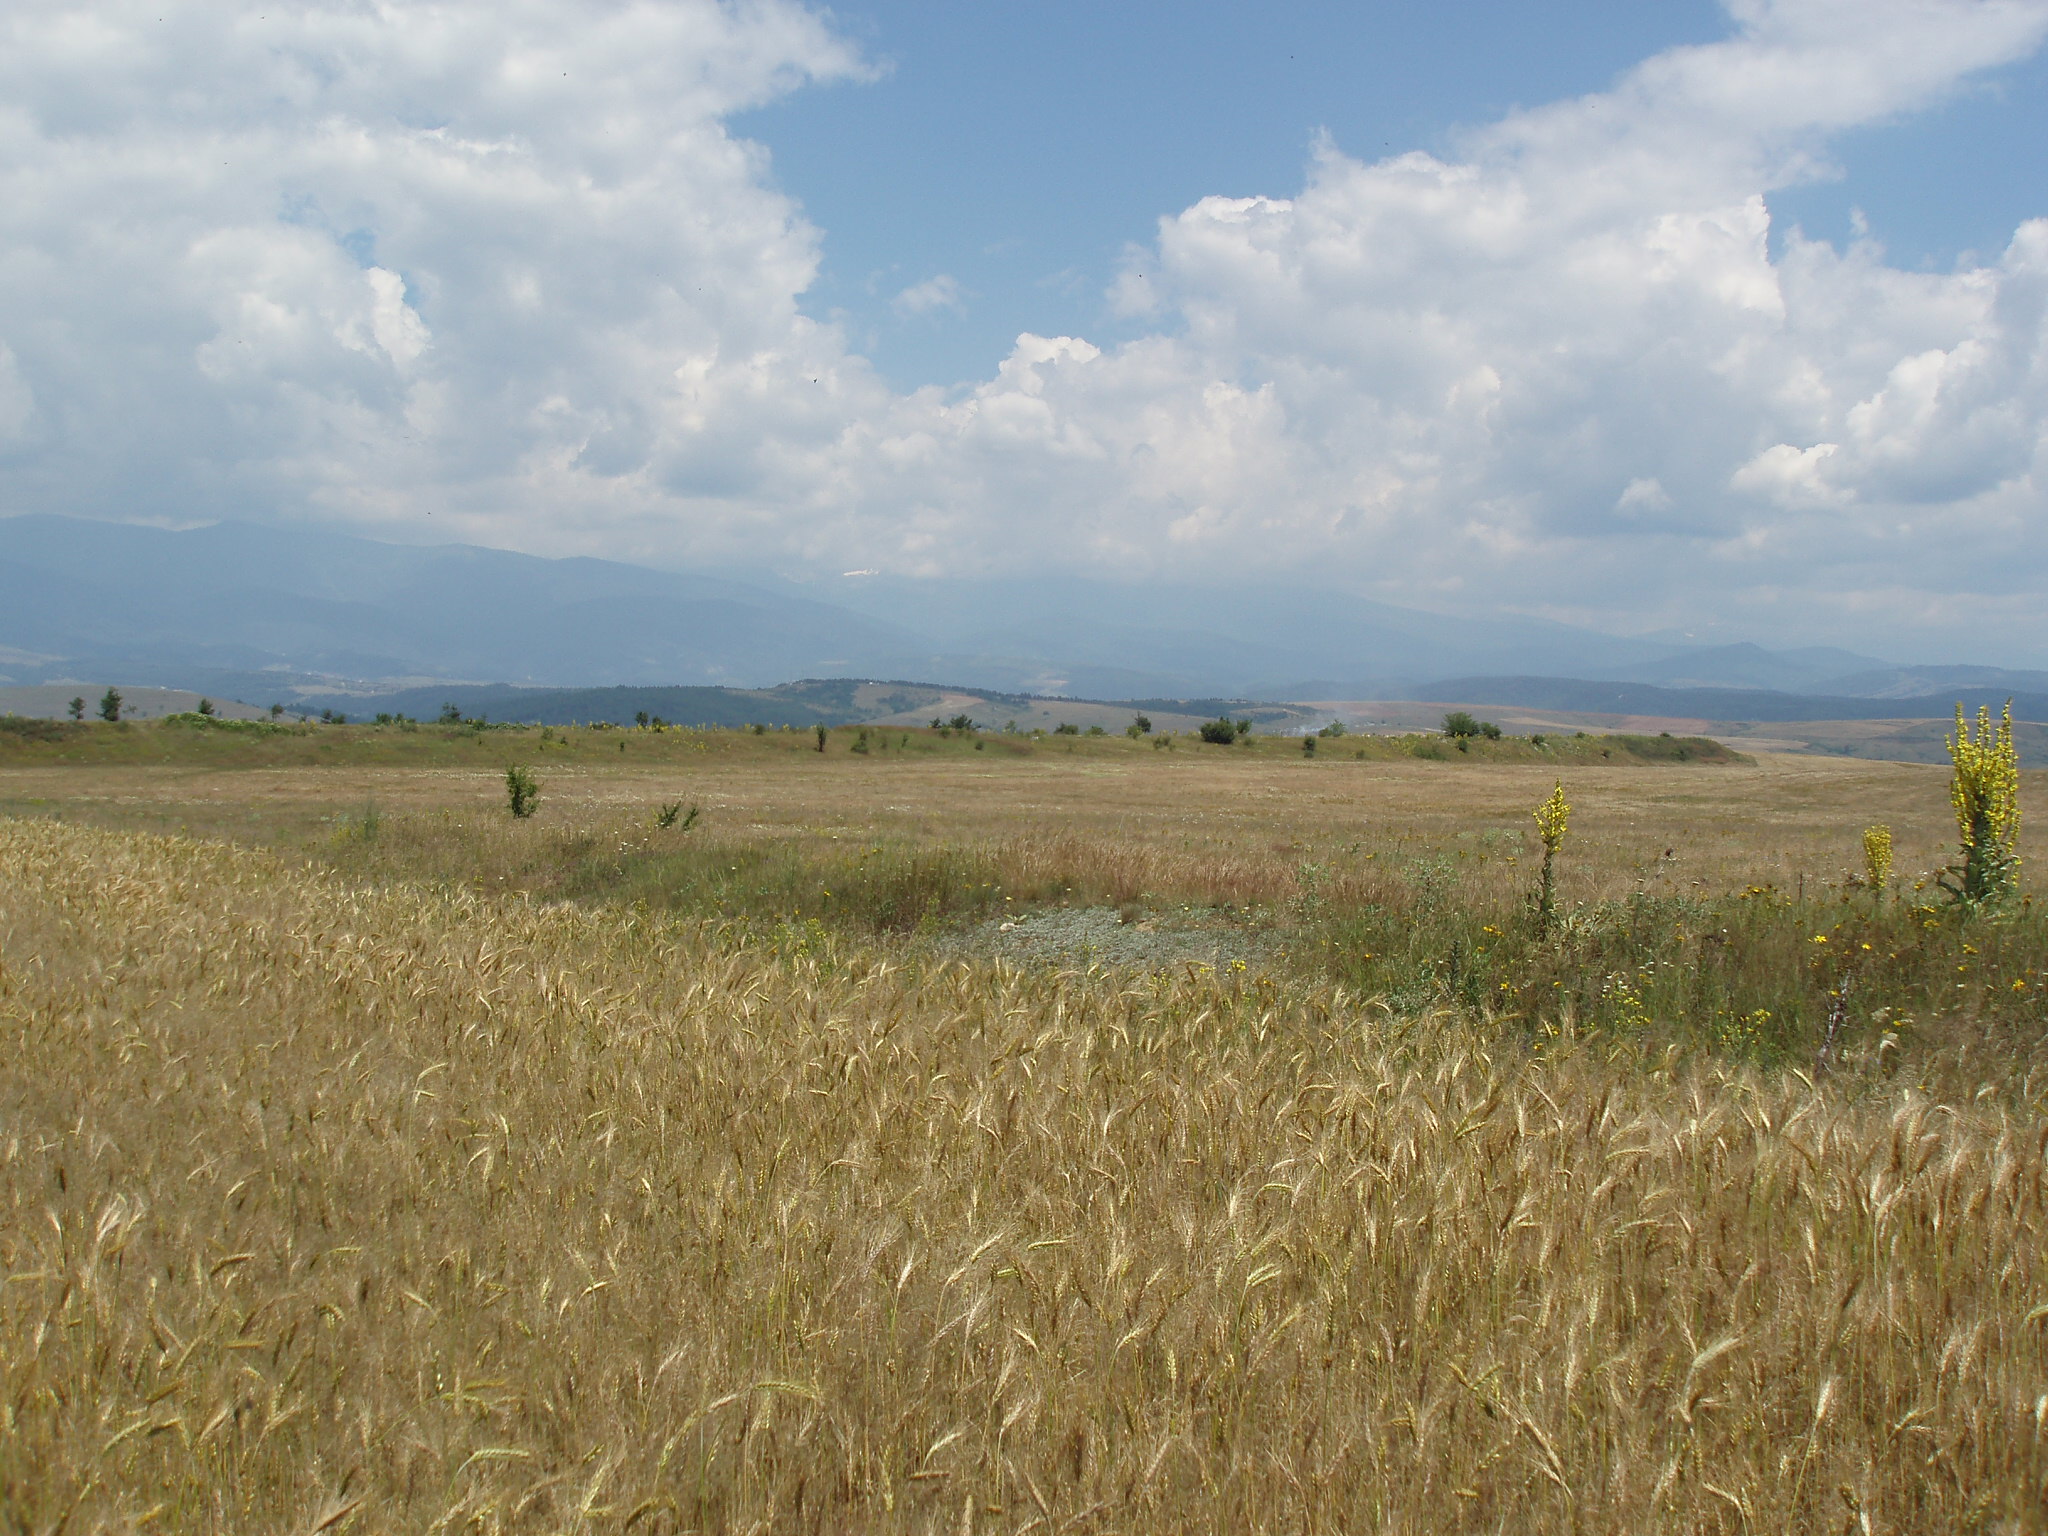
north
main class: Cropland
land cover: Common wheat
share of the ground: > 75 %
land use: Agriculture (excluding fallow land and kitchen gardens)
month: July
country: BG
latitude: 41.8753
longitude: 23.4872
